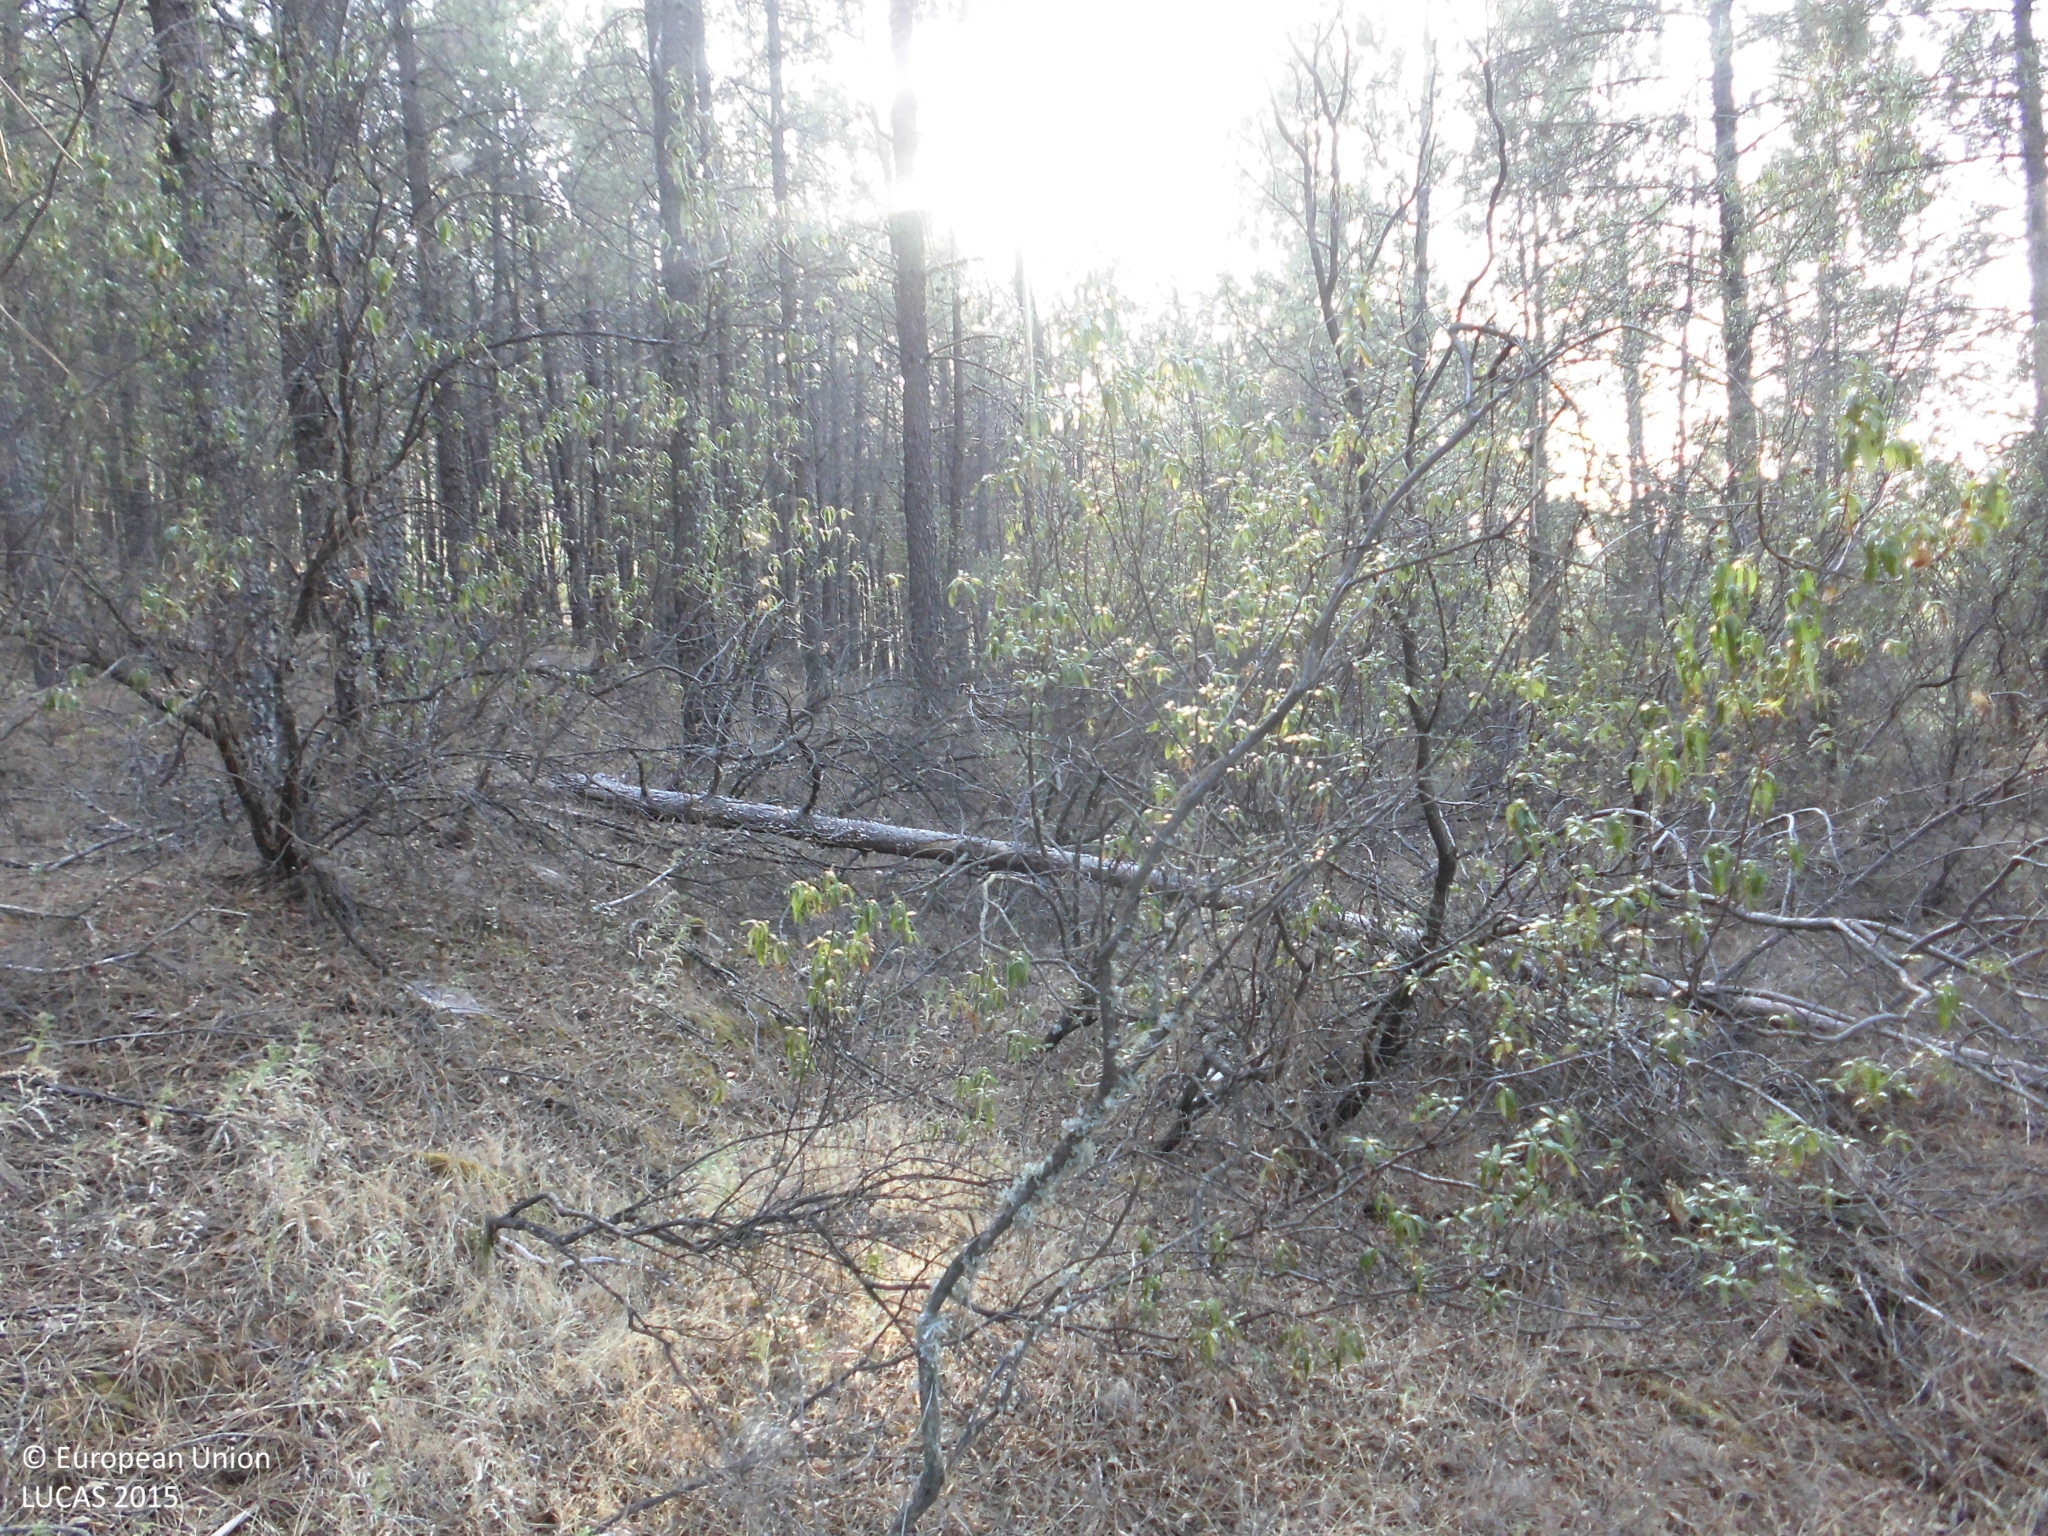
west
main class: Woodland
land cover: Pine dominated coniferous woodland
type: coniferous forest of the mediterranean region
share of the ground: > 75 %
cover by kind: coniferous forest trees 85 %, shrubs 10 %, herbaceous plants 5 %
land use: Forestry
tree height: > 5 m
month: July
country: ES
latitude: 39.7227
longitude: -5.6323
